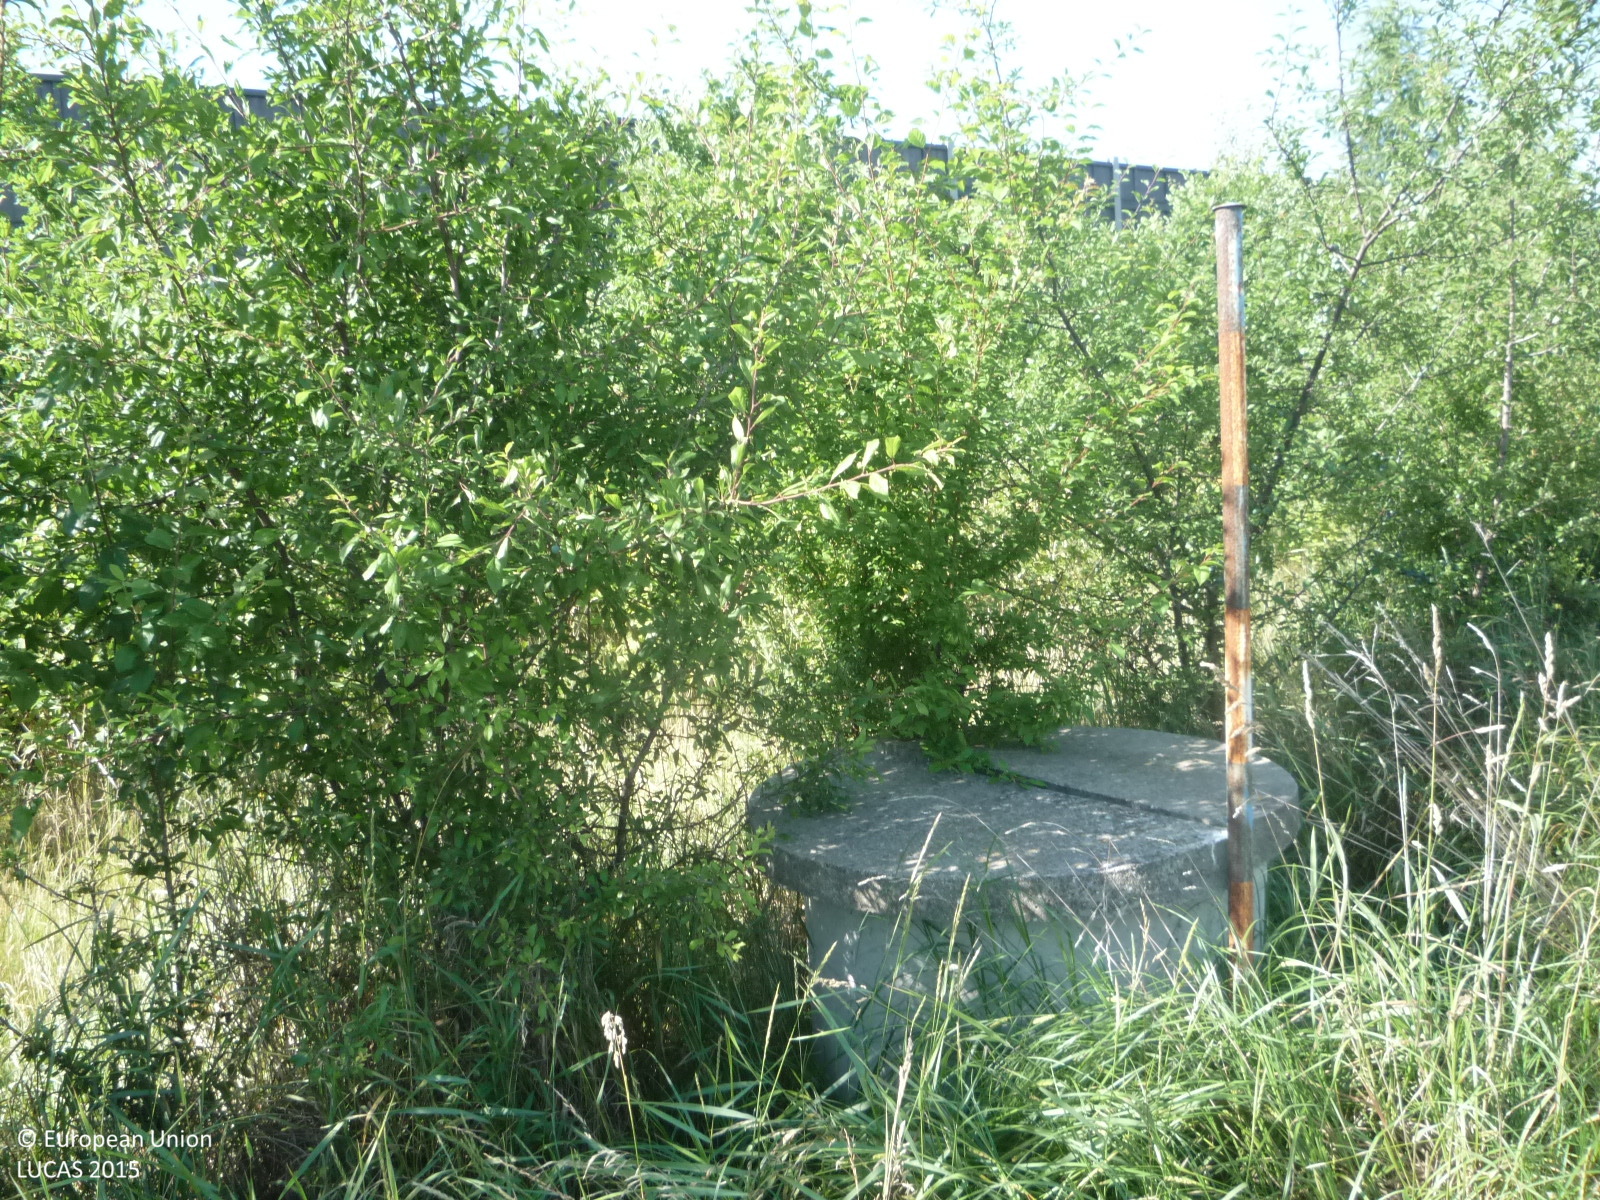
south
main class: Shrubland
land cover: Shrubland with sparse tree cover
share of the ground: > 75 %
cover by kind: shrubs 50 %, herbaceous plants 45 %, broadleaved forest trees 5 %
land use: Agriculture (excluding fallow land and kitchen gardens)
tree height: < 5 m
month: July
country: CZ
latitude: 50.1175
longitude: 15.2479
